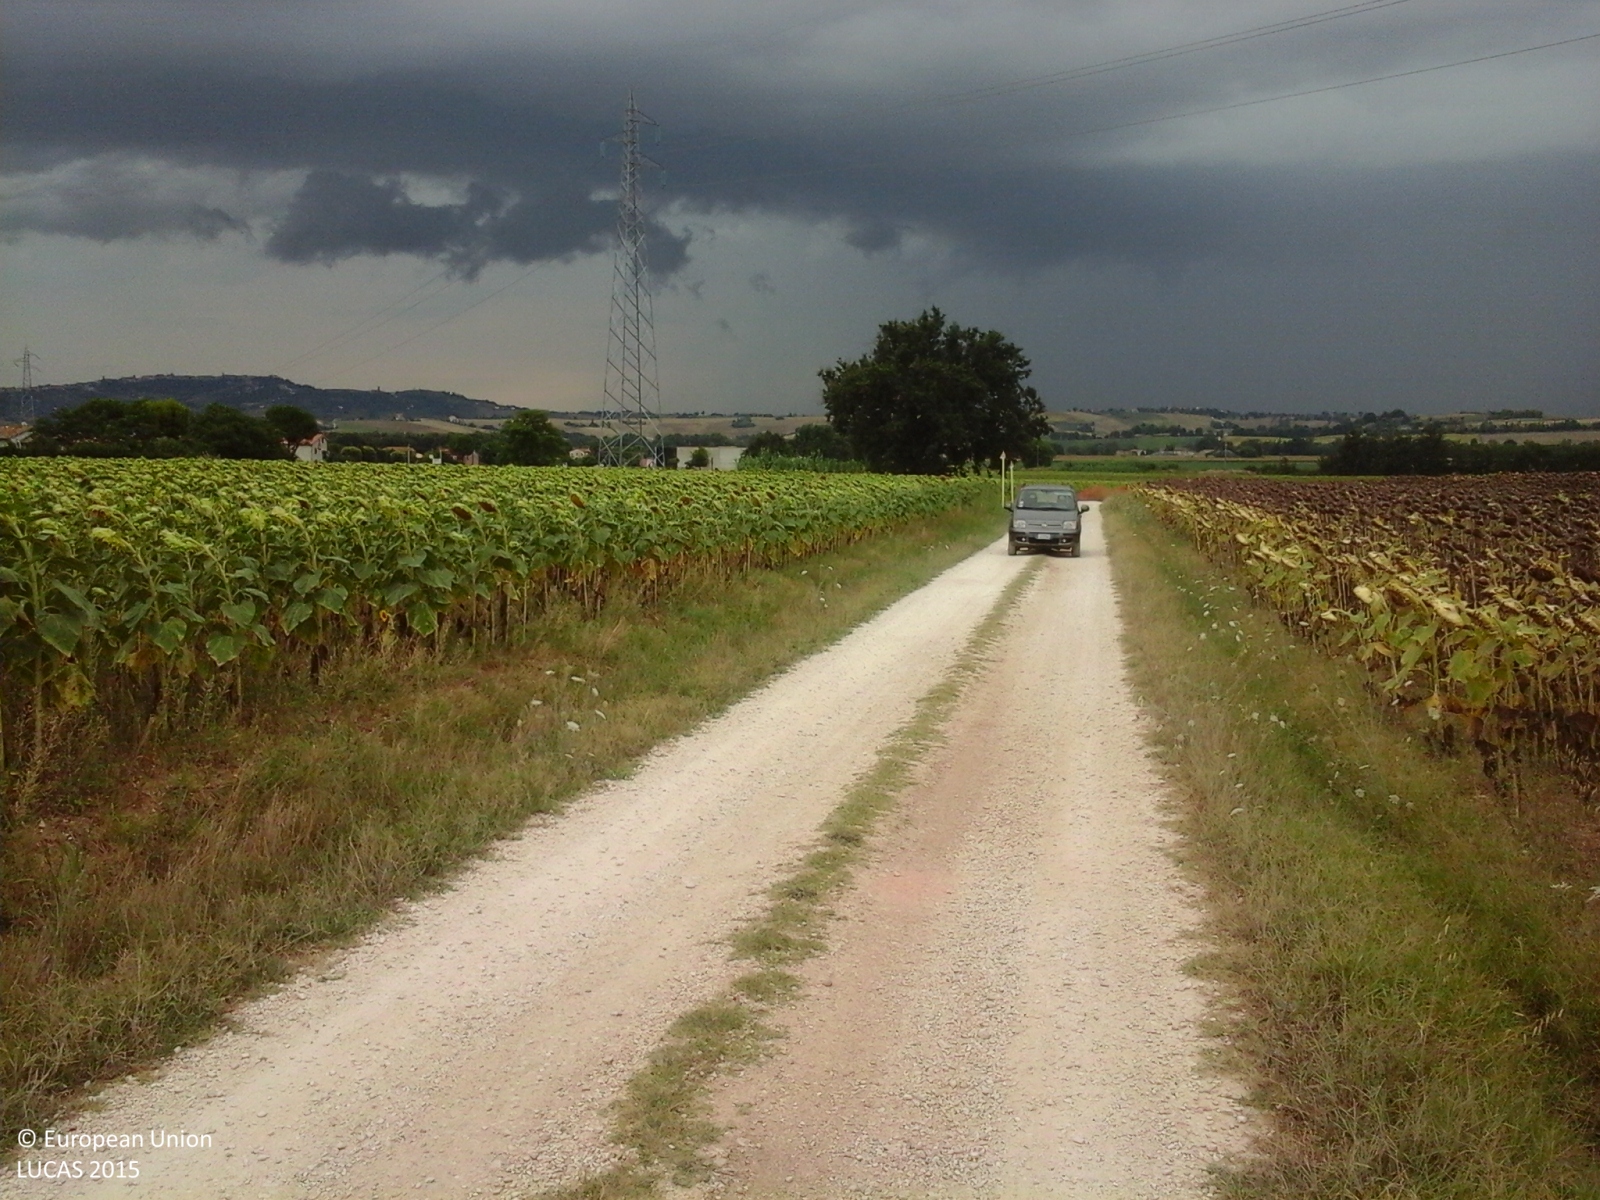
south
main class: Cropland
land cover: Sunflower
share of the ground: > 75 %
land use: Agriculture (excluding fallow land and kitchen gardens)
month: August
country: IT
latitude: 43.4604
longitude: 13.5138
